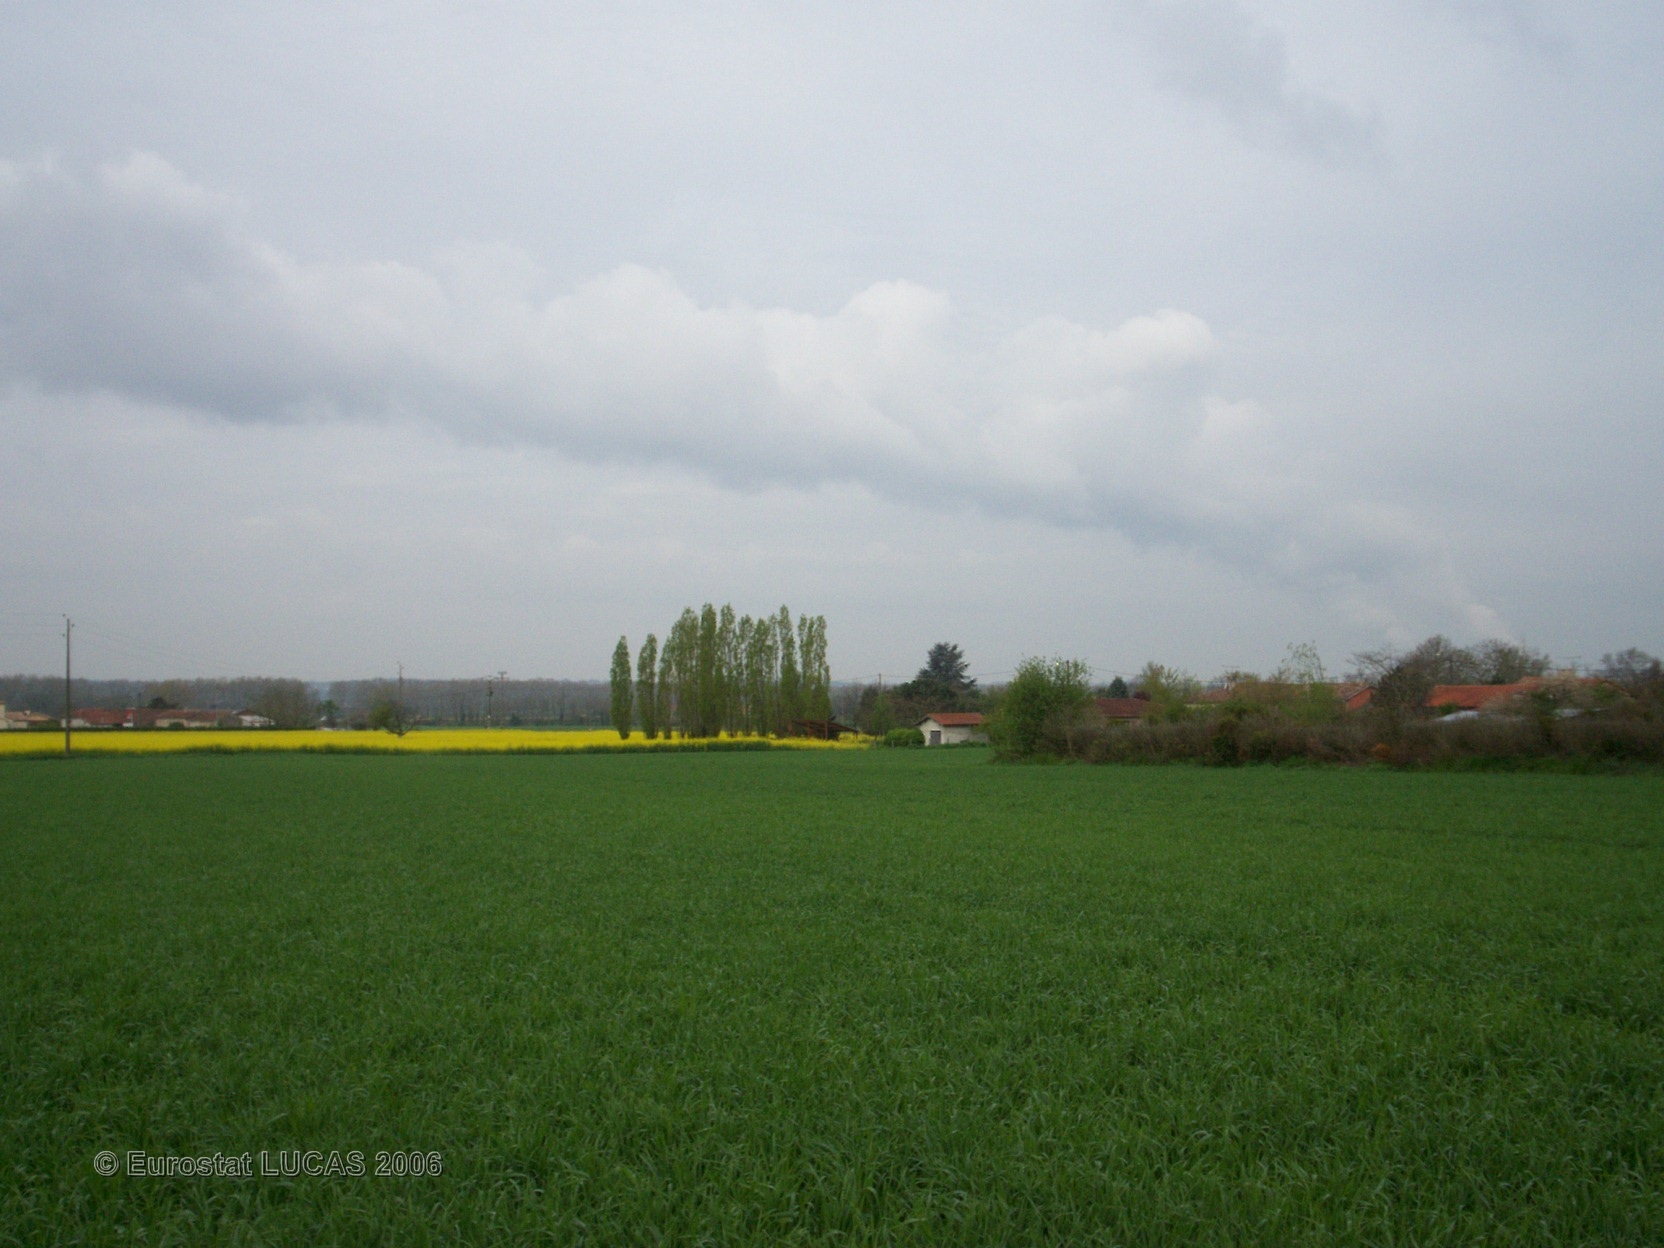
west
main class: Cropland
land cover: Common wheat
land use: Agriculture (excluding fallow land and kitchen gardens)
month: April
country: FR
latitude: 44.1009
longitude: 0.9656
